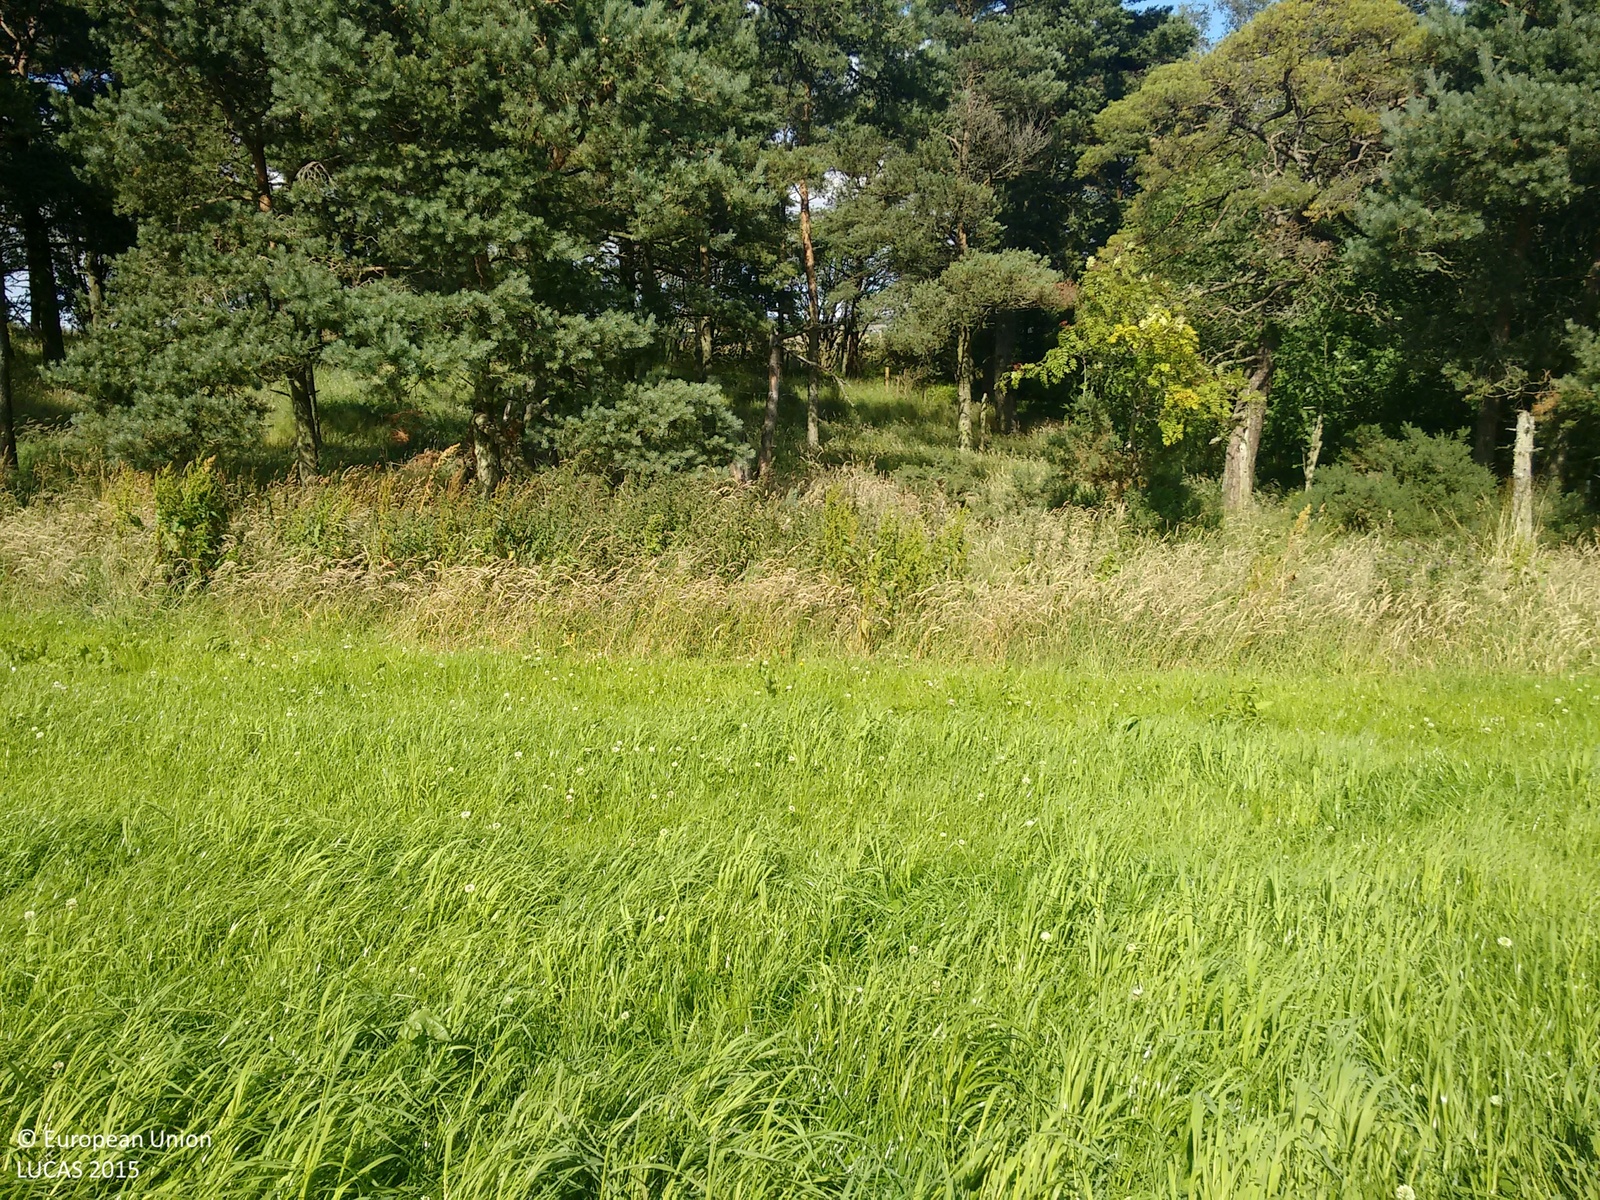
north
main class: Grassland
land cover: Grassland without tree/shrub cover
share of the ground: > 75 %
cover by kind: herbaceous plants 100 %
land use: Agriculture (excluding fallow land and kitchen gardens)
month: August
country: GB
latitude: 57.5470
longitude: -3.0104
